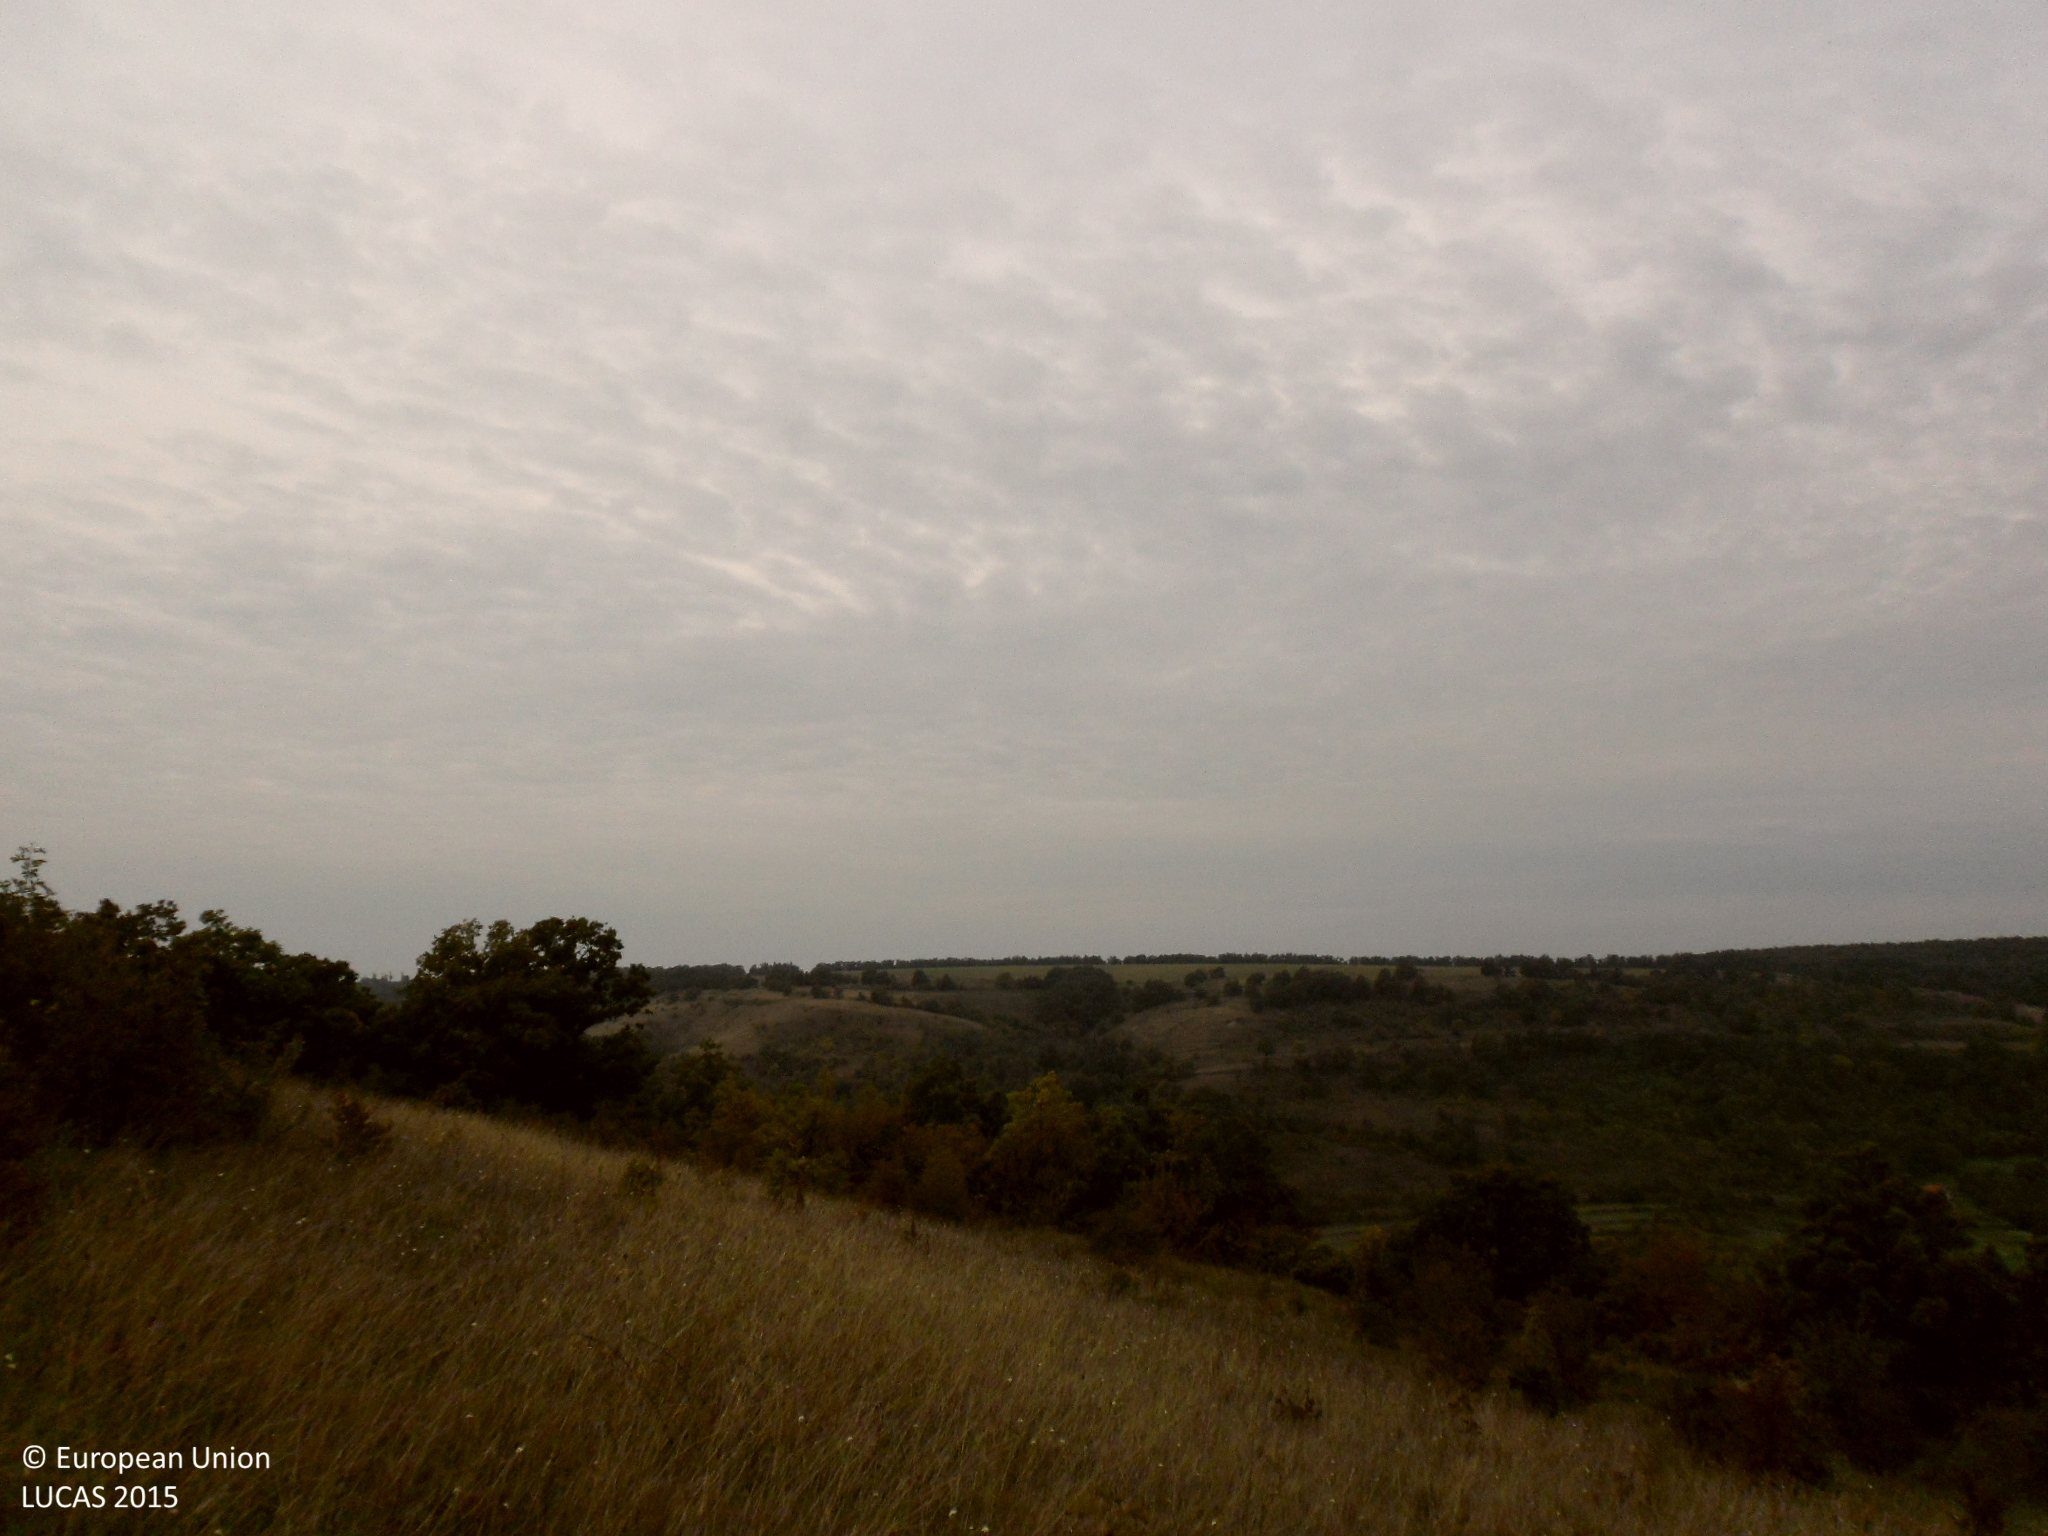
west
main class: Grassland
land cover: Grassland with sparse tree/shrub cover
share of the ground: > 75 %
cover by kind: herbaceous plants 90 %, broadleaved forest trees 5 %, shrubs 5 %
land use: Semi-natural and natural areas not in use
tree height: > 5 m
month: October
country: BG
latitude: 43.9963
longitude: 22.6184
